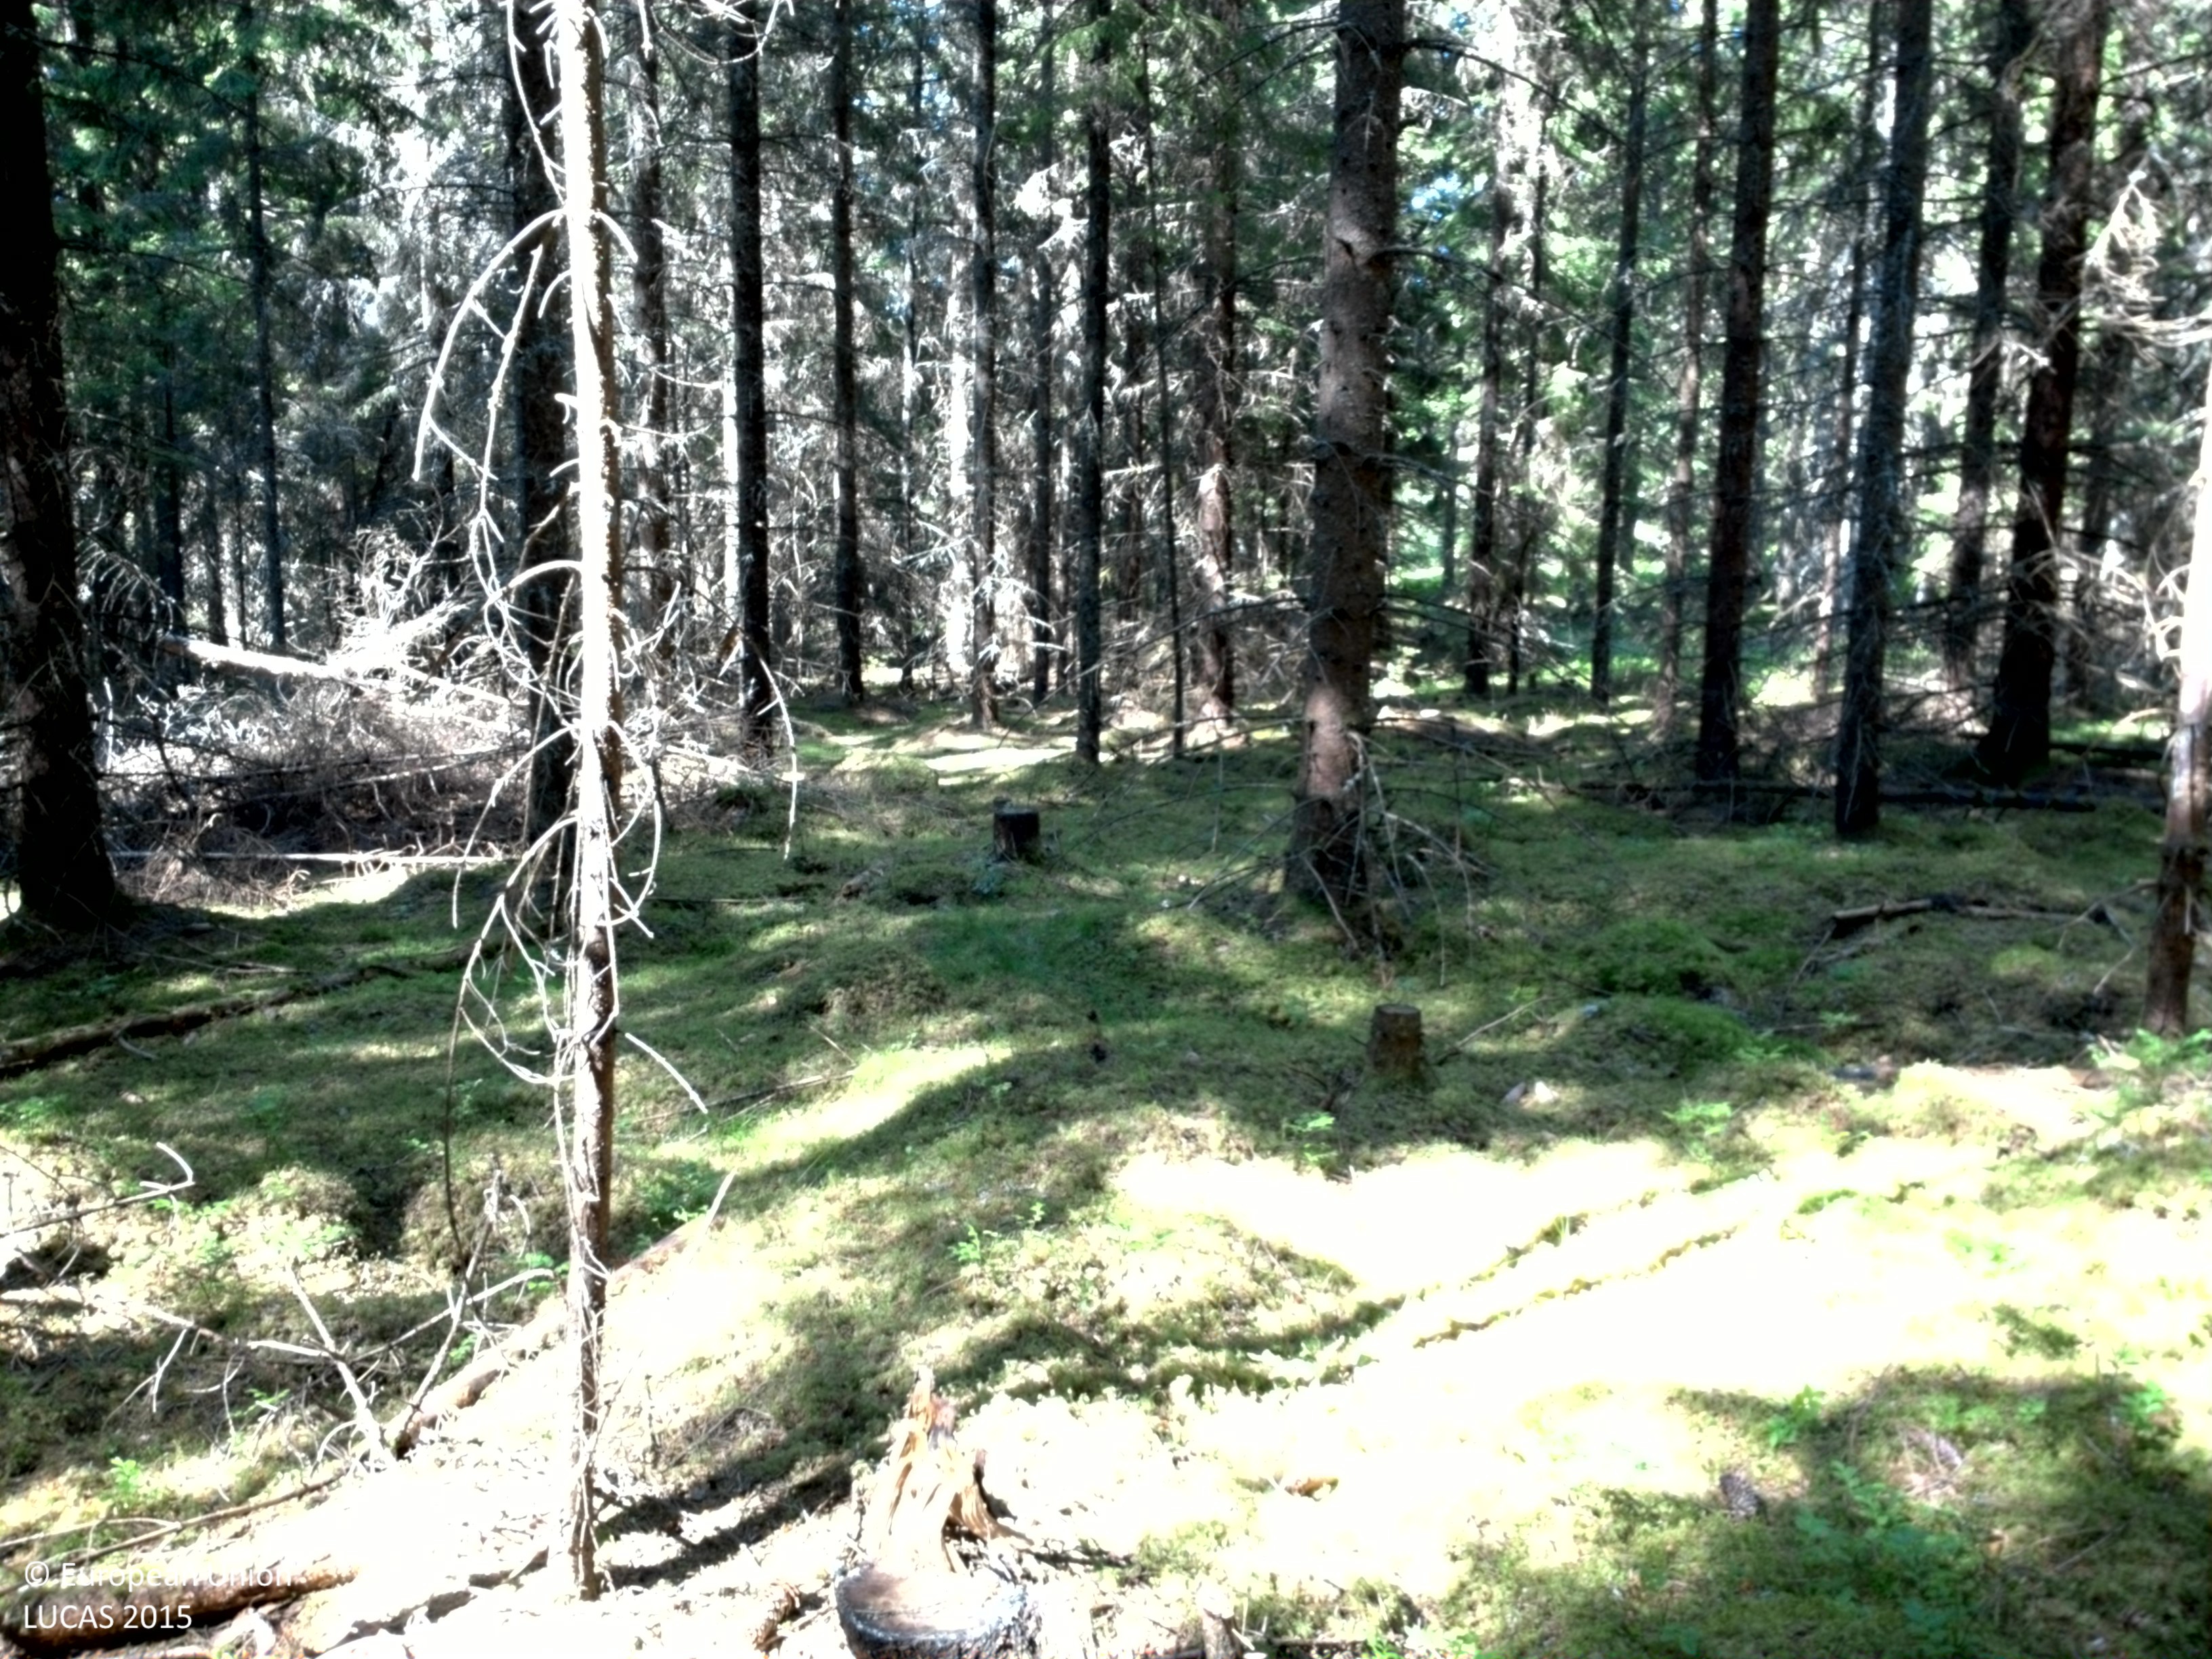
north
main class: Woodland
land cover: Spruce dominated coniferous woodland
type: boreal forest
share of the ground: 25 - 50 %
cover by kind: coniferous forest trees 40 %, lichens and mosses 40 %, herbaceous plants 20 %
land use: Forestry
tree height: > 5 m
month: July
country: SE
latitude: 58.7208
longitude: 14.4999
